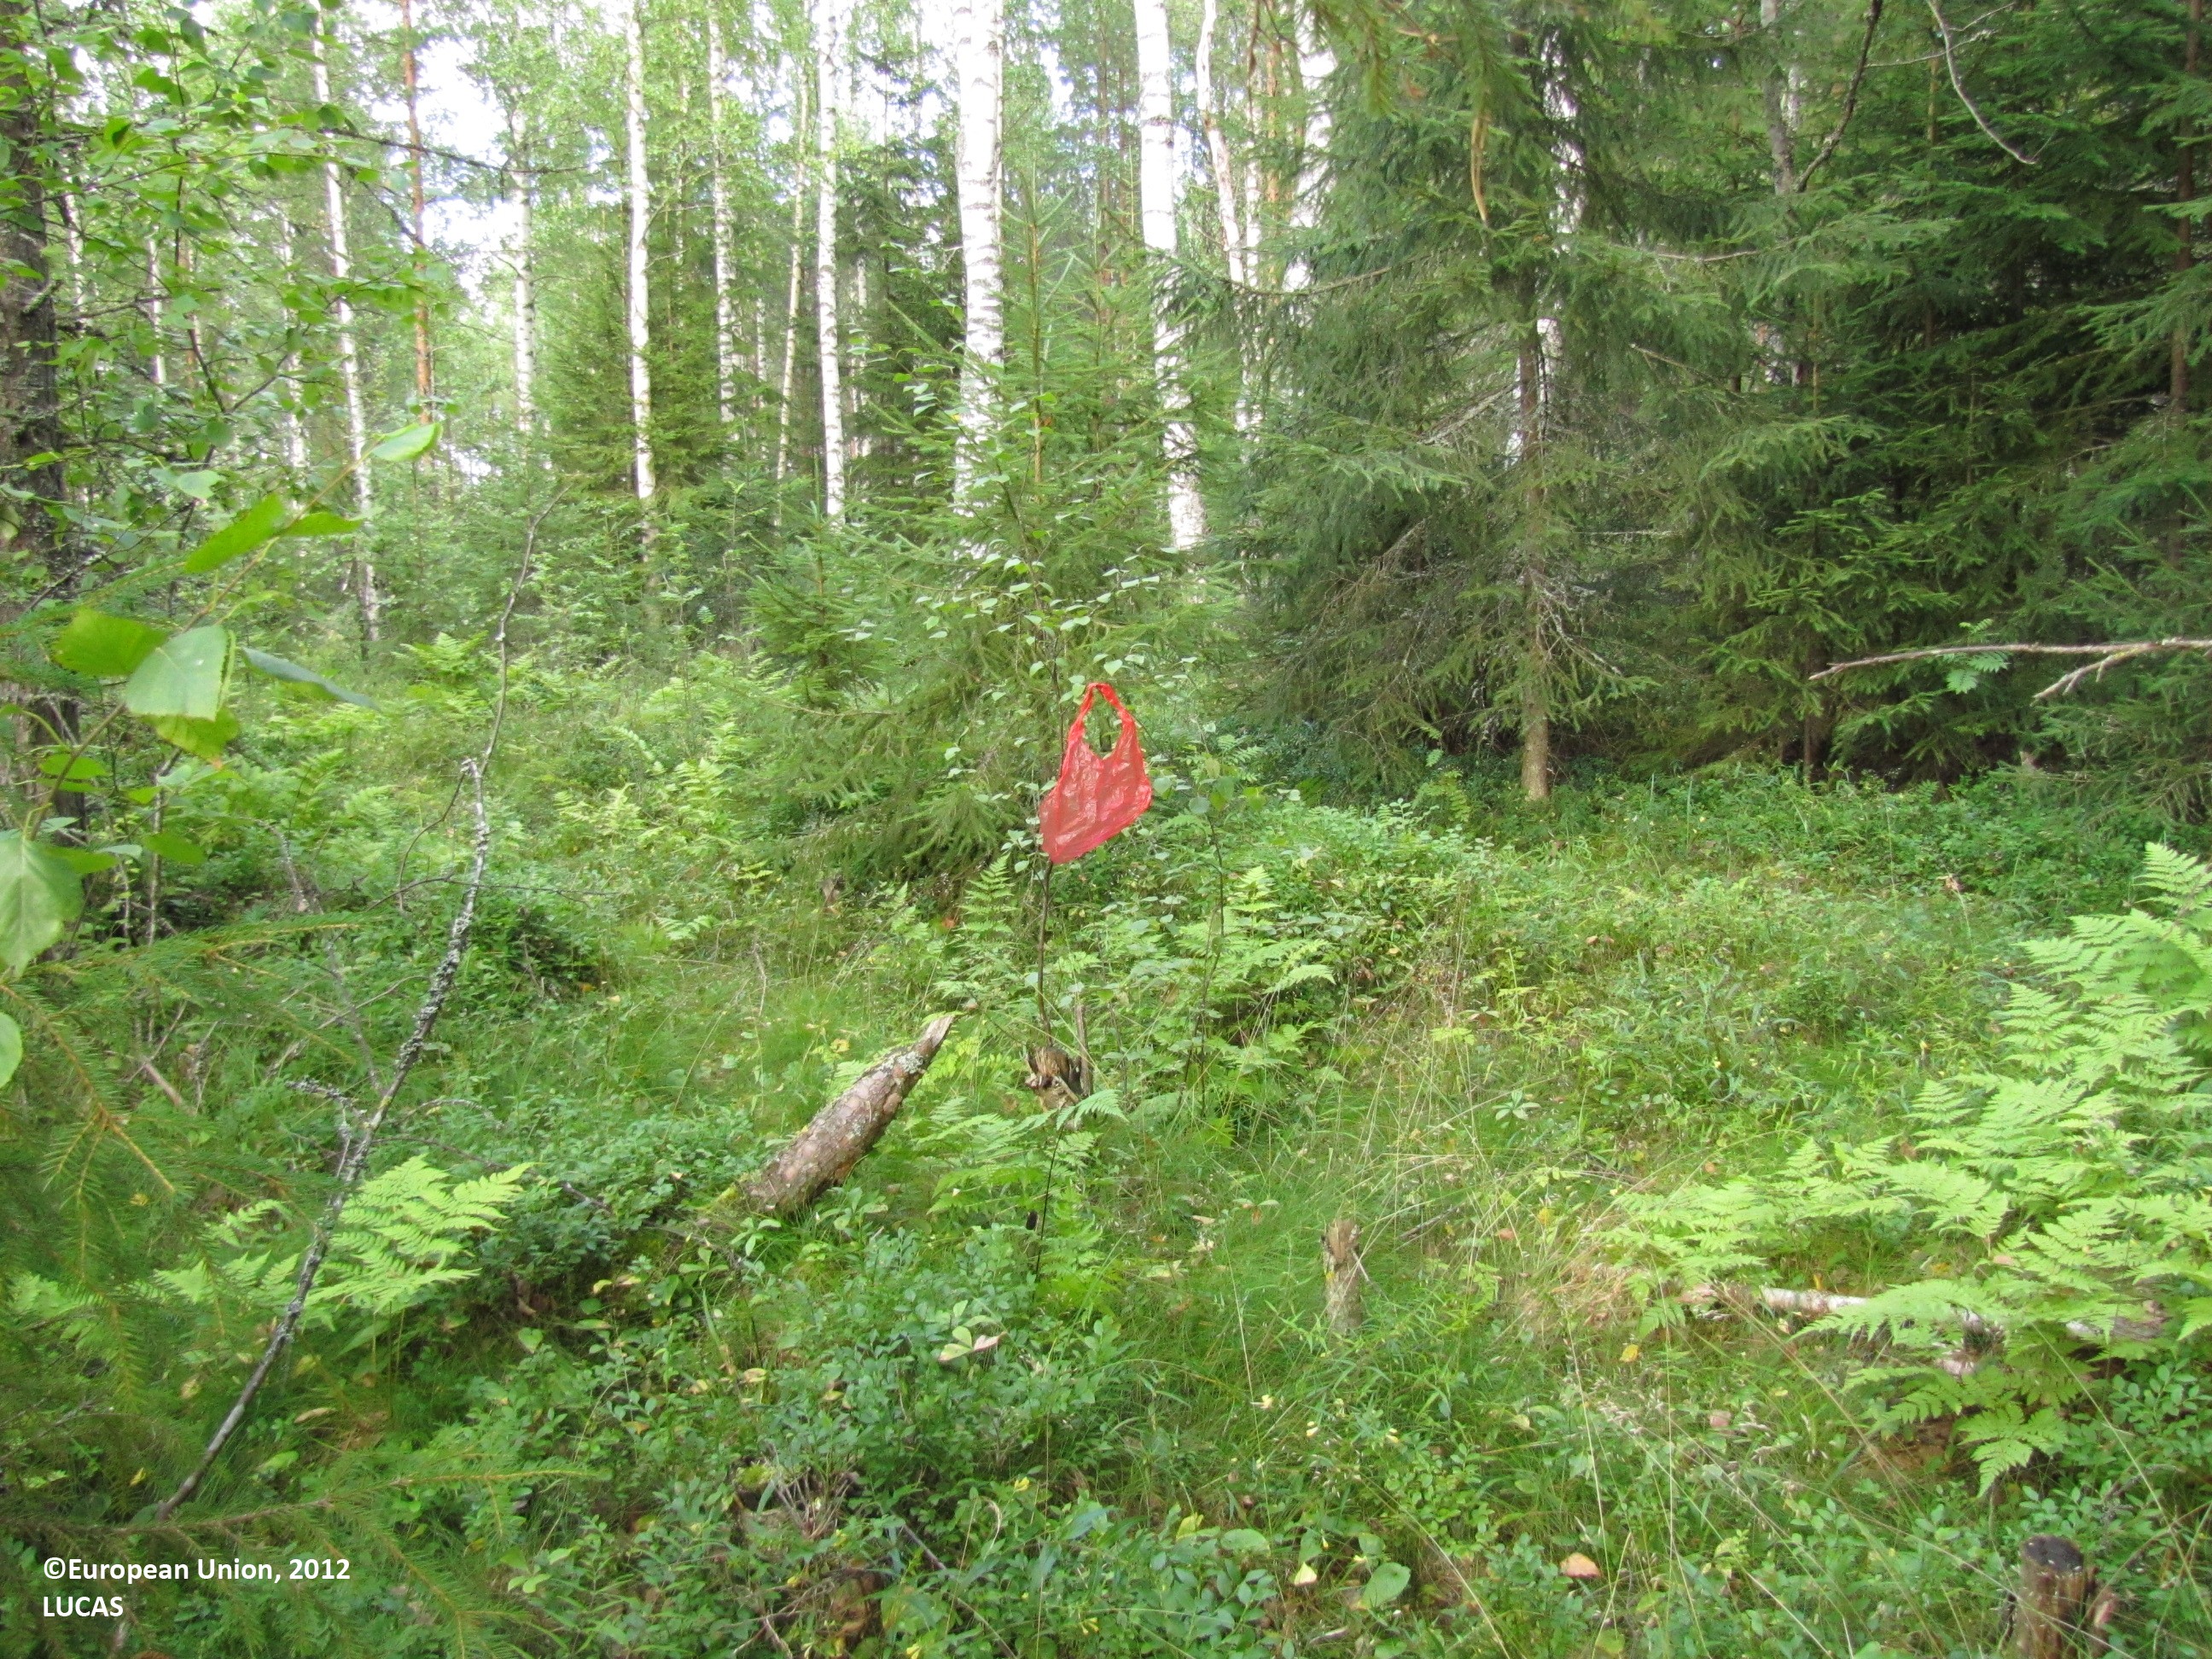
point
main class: Woodland
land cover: Spruce dominated mixed woodland
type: boreal forest
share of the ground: 50 - 75 %
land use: Forestry
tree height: > 5 m
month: August
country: FI
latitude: 61.7104
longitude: 23.0647
